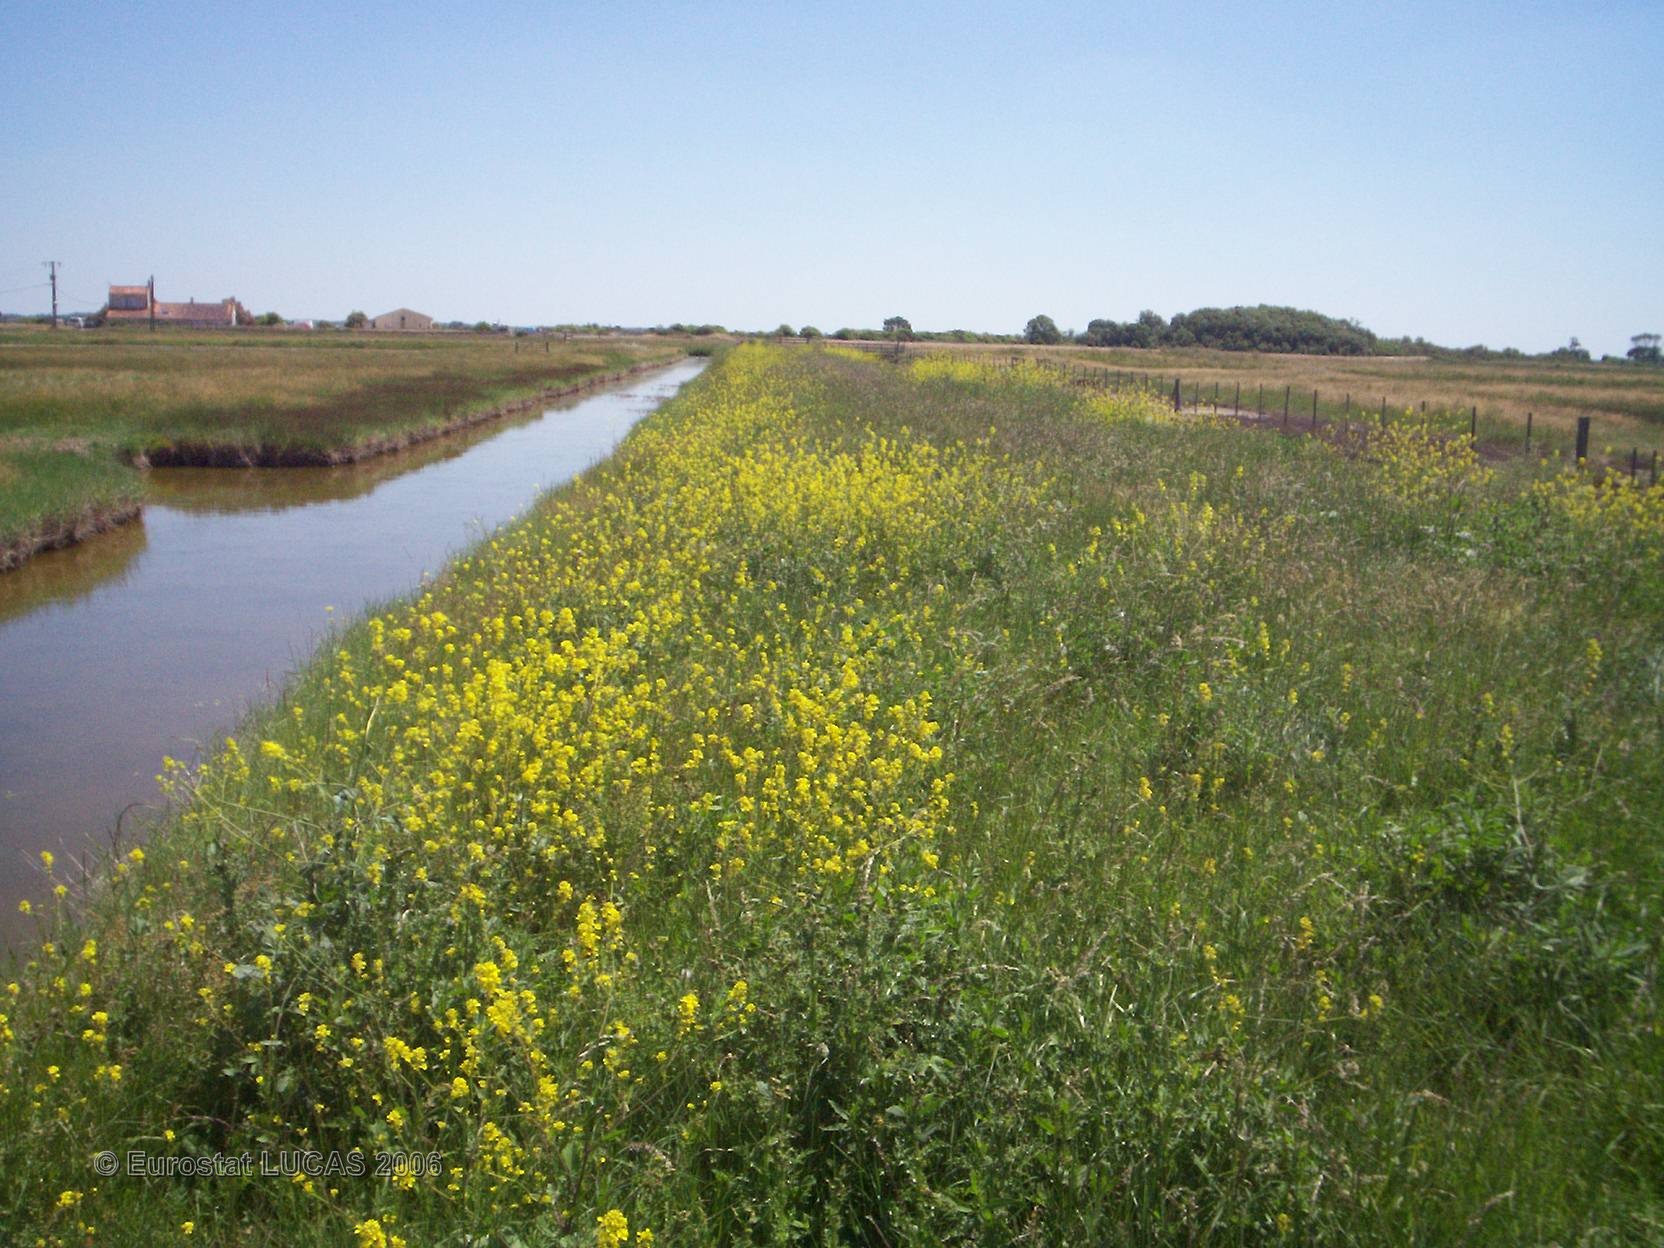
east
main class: Grassland
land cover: Grassland without tree/shrub cover
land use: Agriculture (excluding fallow land and kitchen gardens)
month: June
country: FR
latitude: 45.9013
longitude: -1.0760
